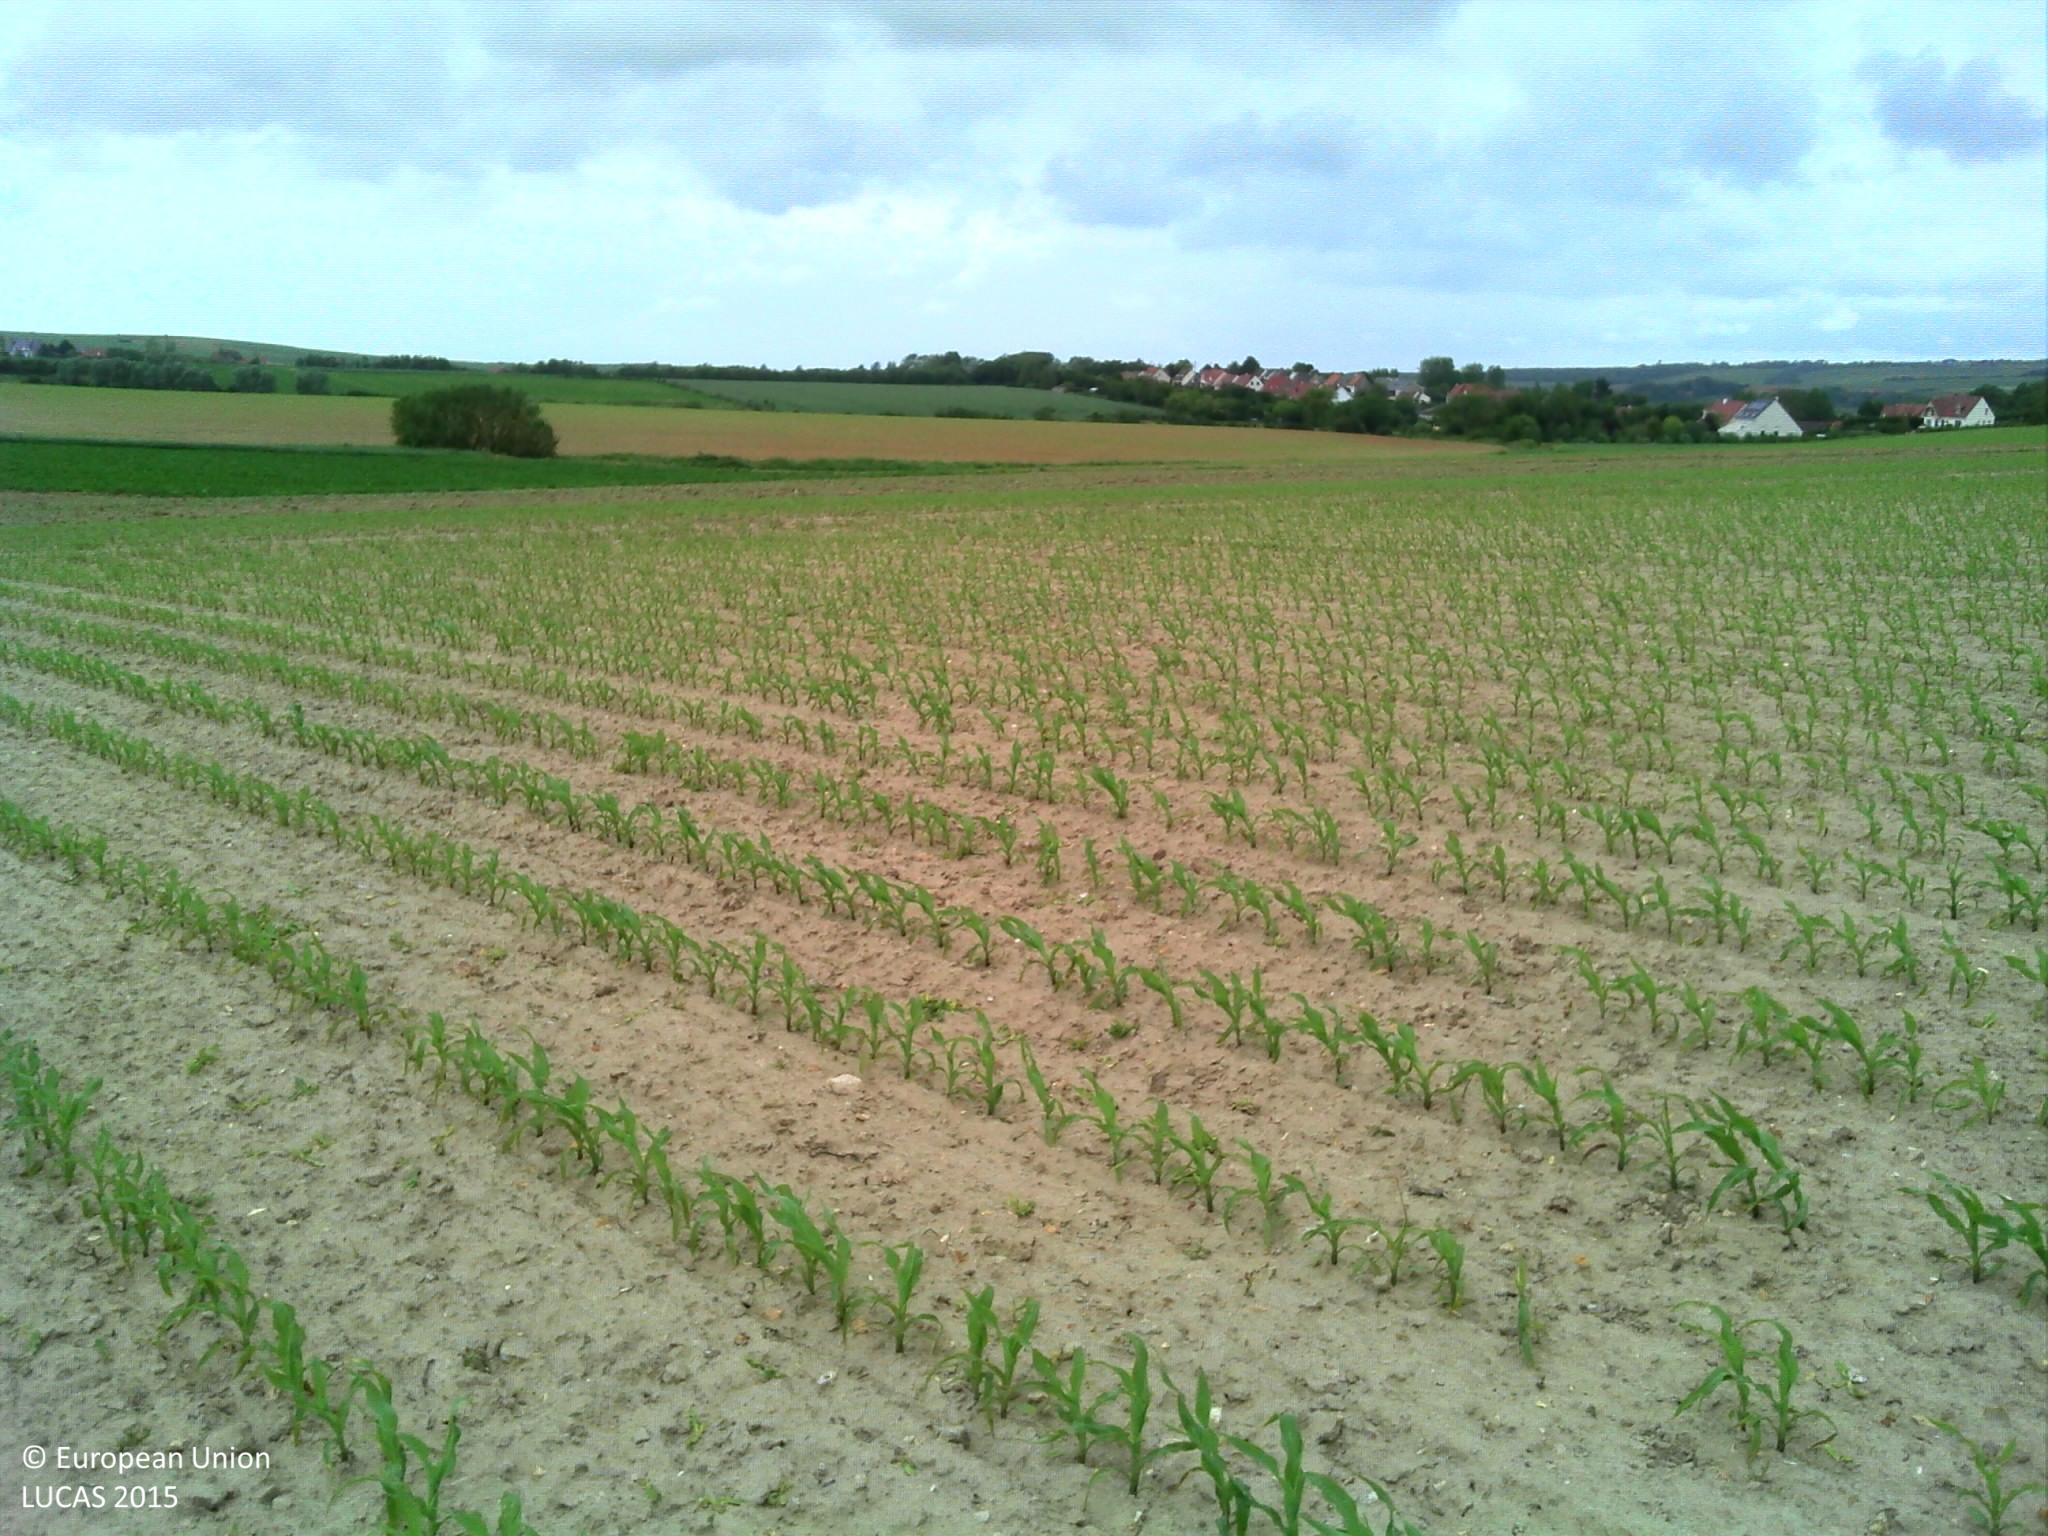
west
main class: Cropland
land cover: Maize
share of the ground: 10 - 25 %
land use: Agriculture (excluding fallow land and kitchen gardens)
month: June
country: FR
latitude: 50.8018
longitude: 1.6813
